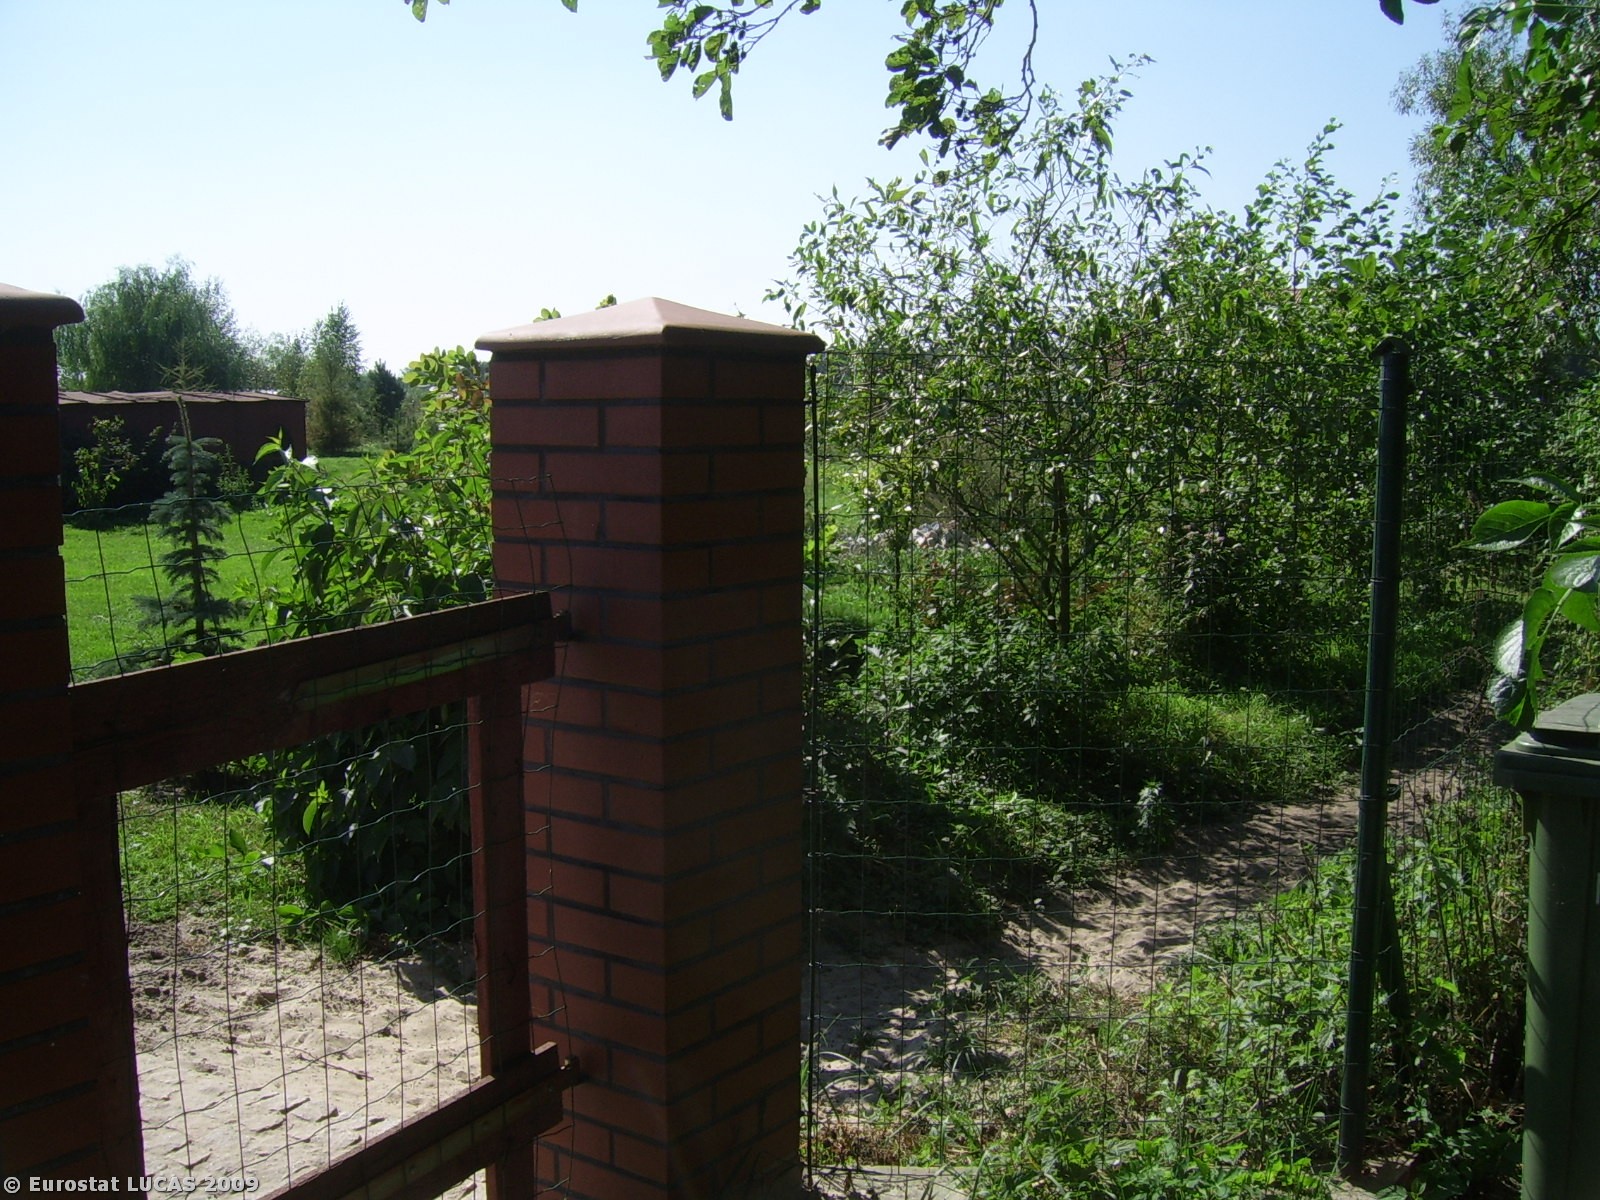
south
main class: Grassland
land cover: Grassland with sparse tree/shrub cover
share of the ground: > 75 %
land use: Residential
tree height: < 5 m
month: September
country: PL
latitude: 52.9775
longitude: 18.7328
